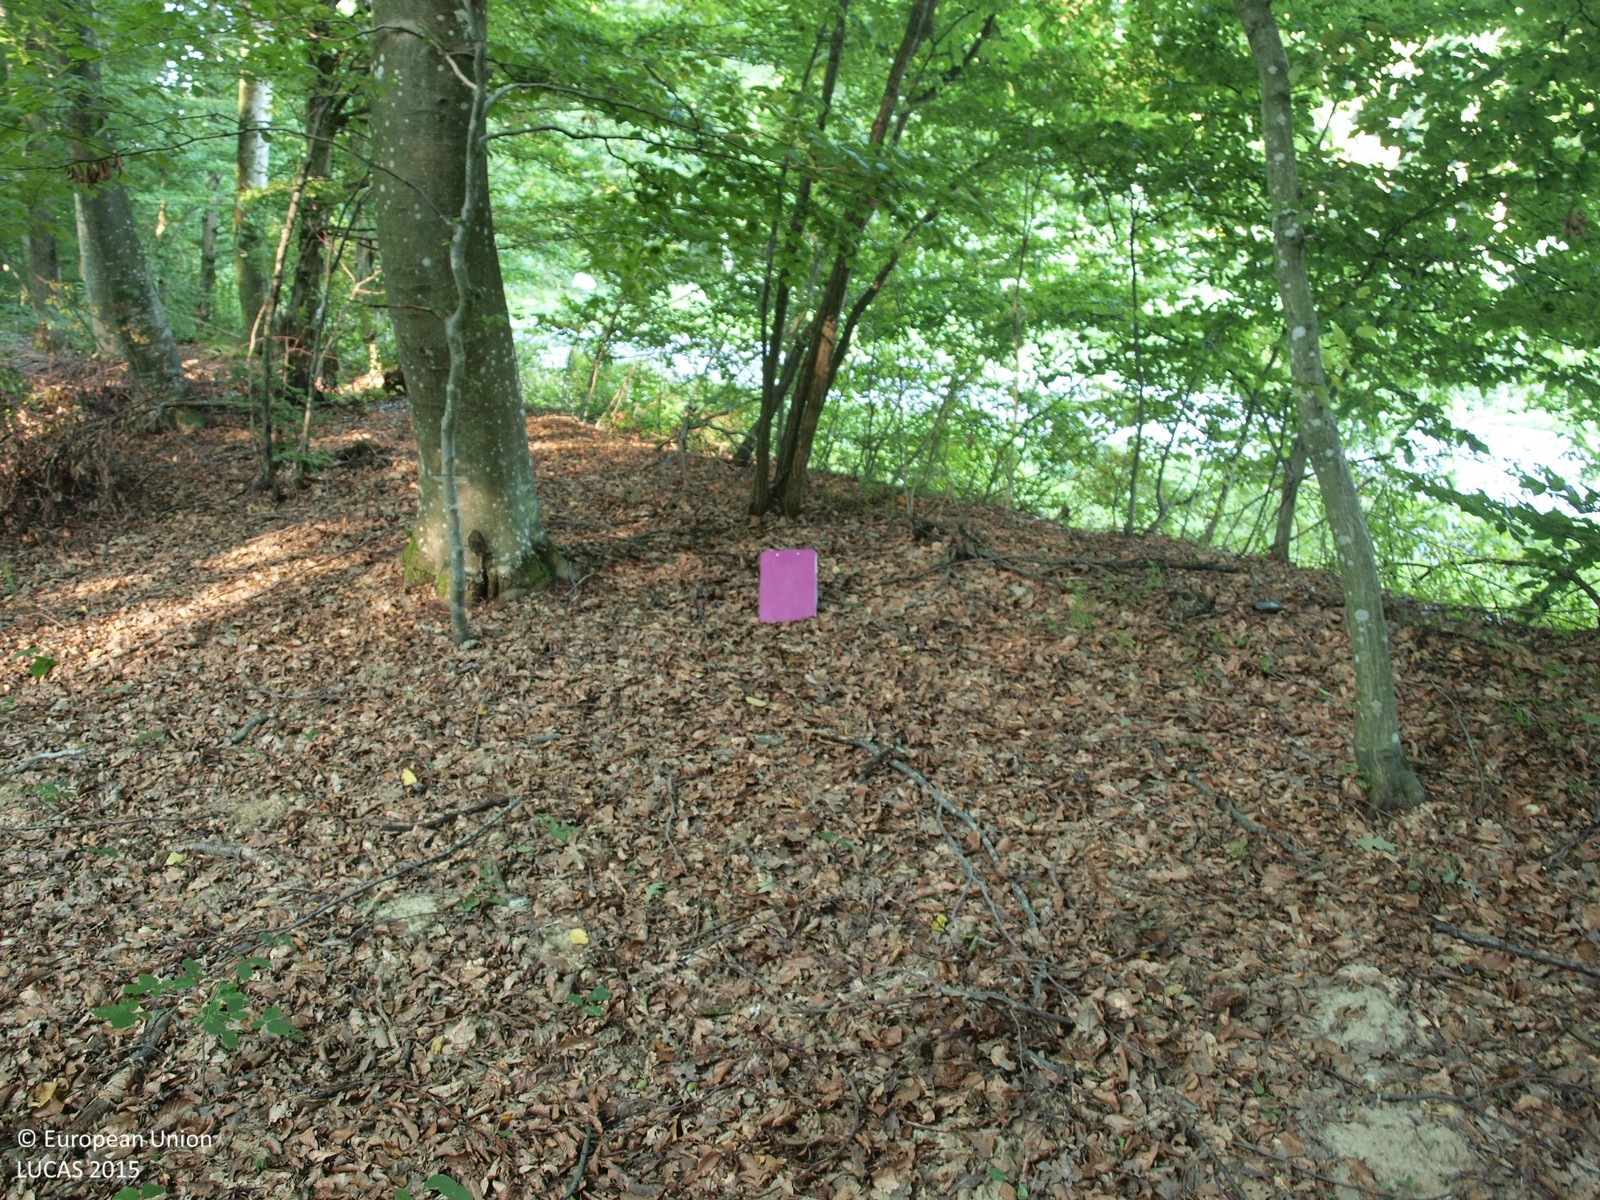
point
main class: Woodland
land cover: Broadleaved woodland
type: mesophytic deciduous forest
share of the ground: > 75 %
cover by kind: broadleaved forest trees 100 %
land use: Forestry
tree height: > 5 m
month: August
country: HR
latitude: 45.8609
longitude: 16.5555
